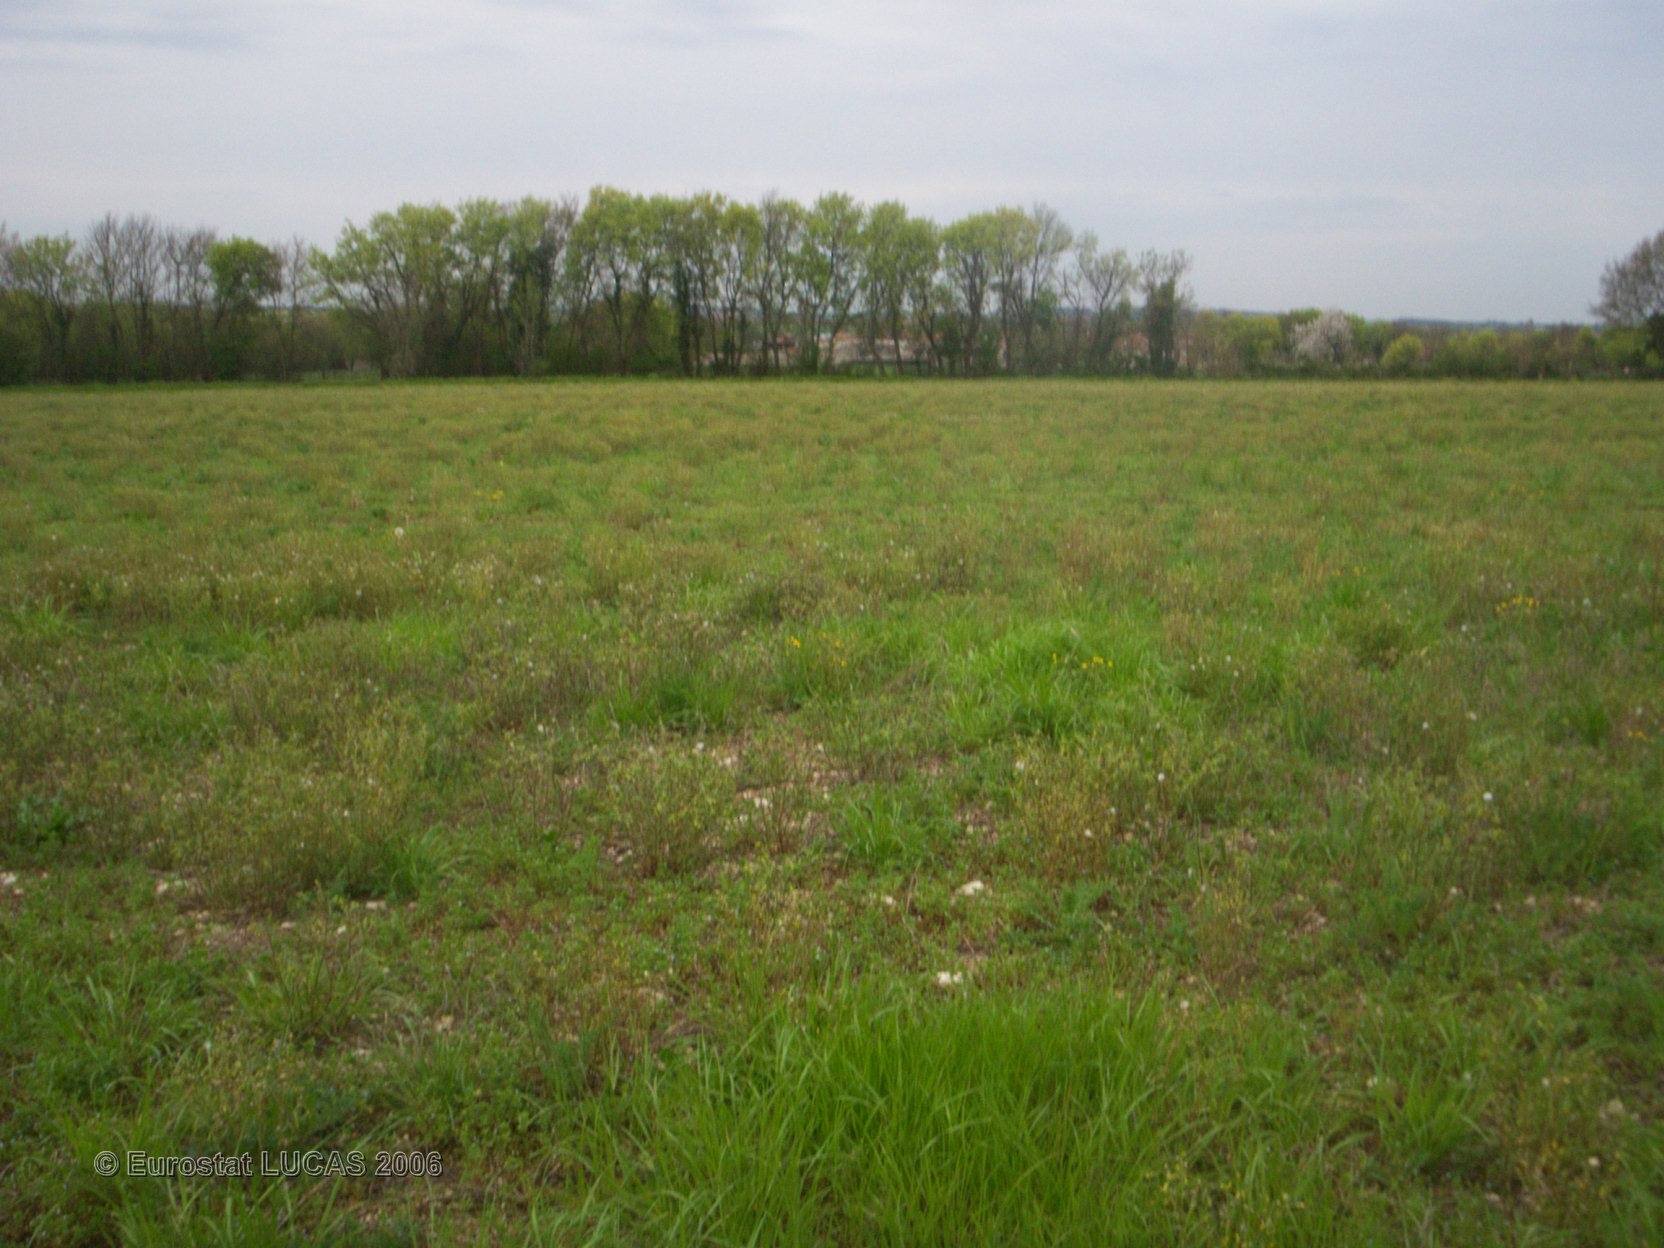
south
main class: Grassland
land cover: Grassland without tree/shrub cover
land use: Agriculture (excluding fallow land and kitchen gardens)
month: April
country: FR
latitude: 46.1036
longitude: -0.6993
